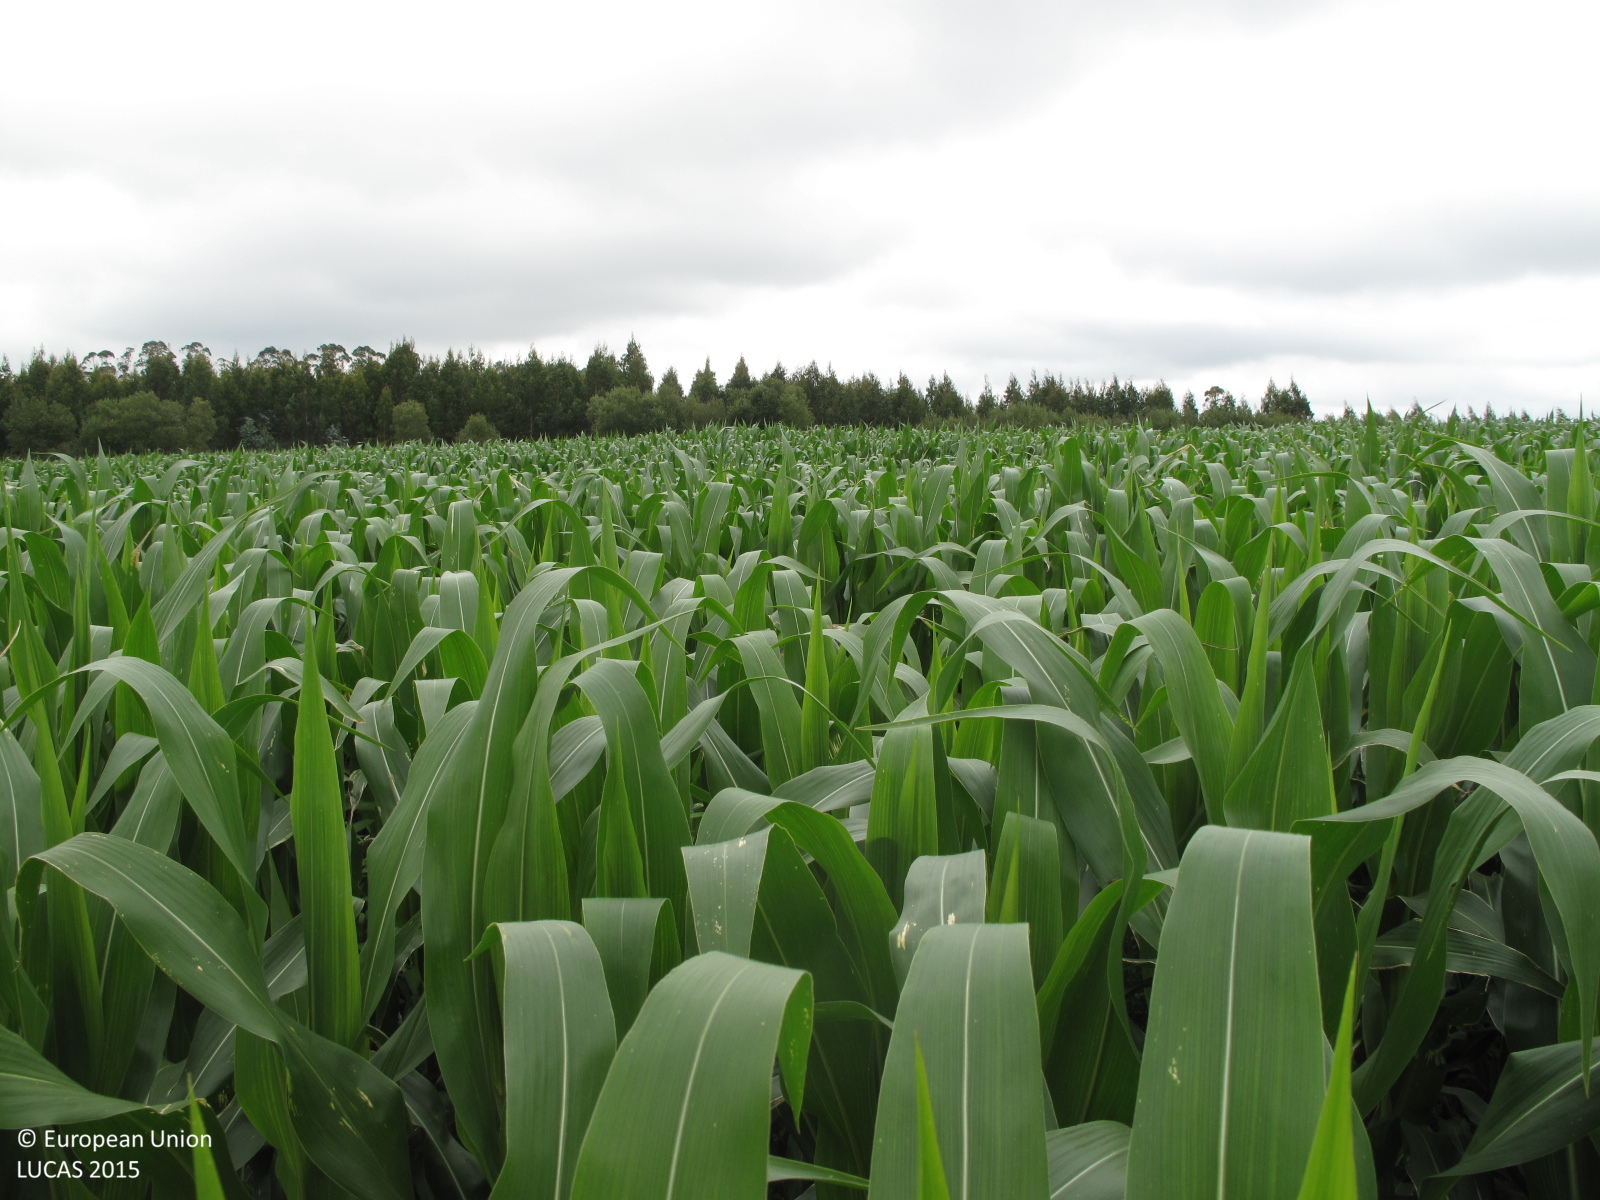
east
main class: Cropland
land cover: Maize
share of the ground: > 75 %
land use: Agriculture (excluding fallow land and kitchen gardens)
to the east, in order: Maize; Broadleaved woodland; Grass margins; Paved roads, cycling and walking lanes
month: July
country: ES
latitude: 43.0989
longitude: -8.1695
